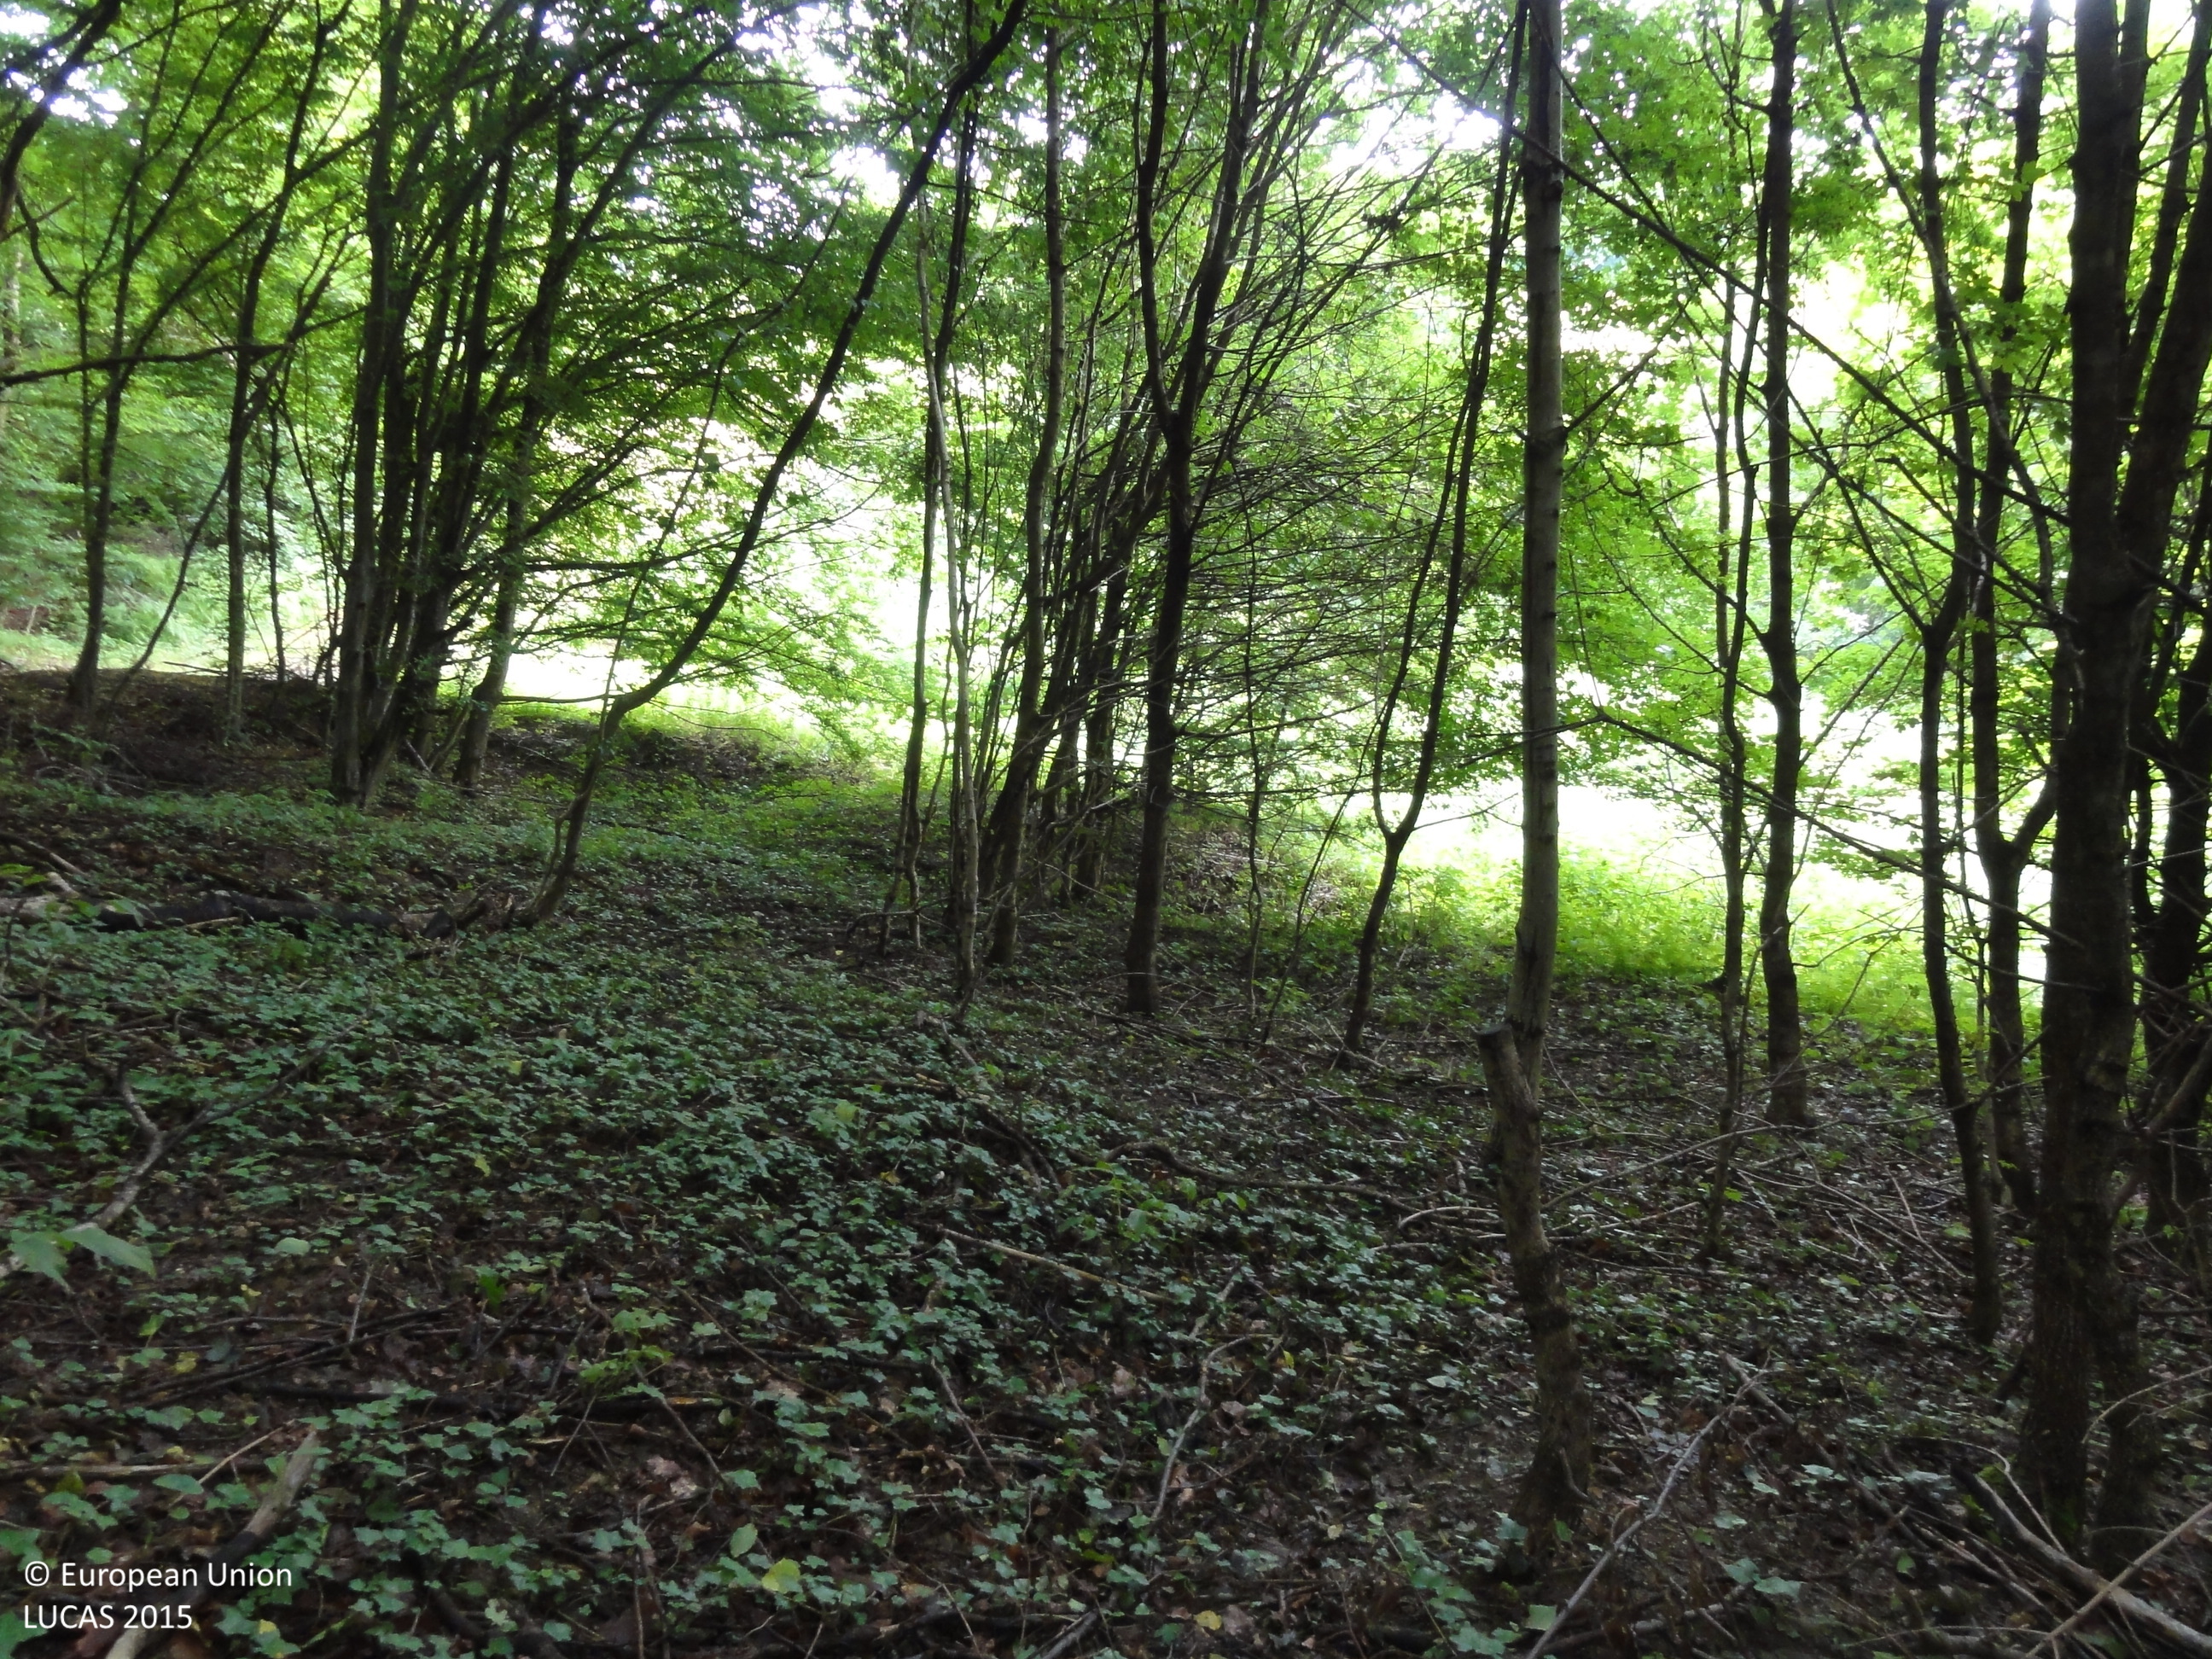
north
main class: Woodland
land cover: Broadleaved woodland
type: mesophytic deciduous forest
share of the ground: > 75 %
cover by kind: broadleaved forest trees 100 %
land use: Forestry
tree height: > 5 m
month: June
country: SI
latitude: 46.6748
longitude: 15.5811
